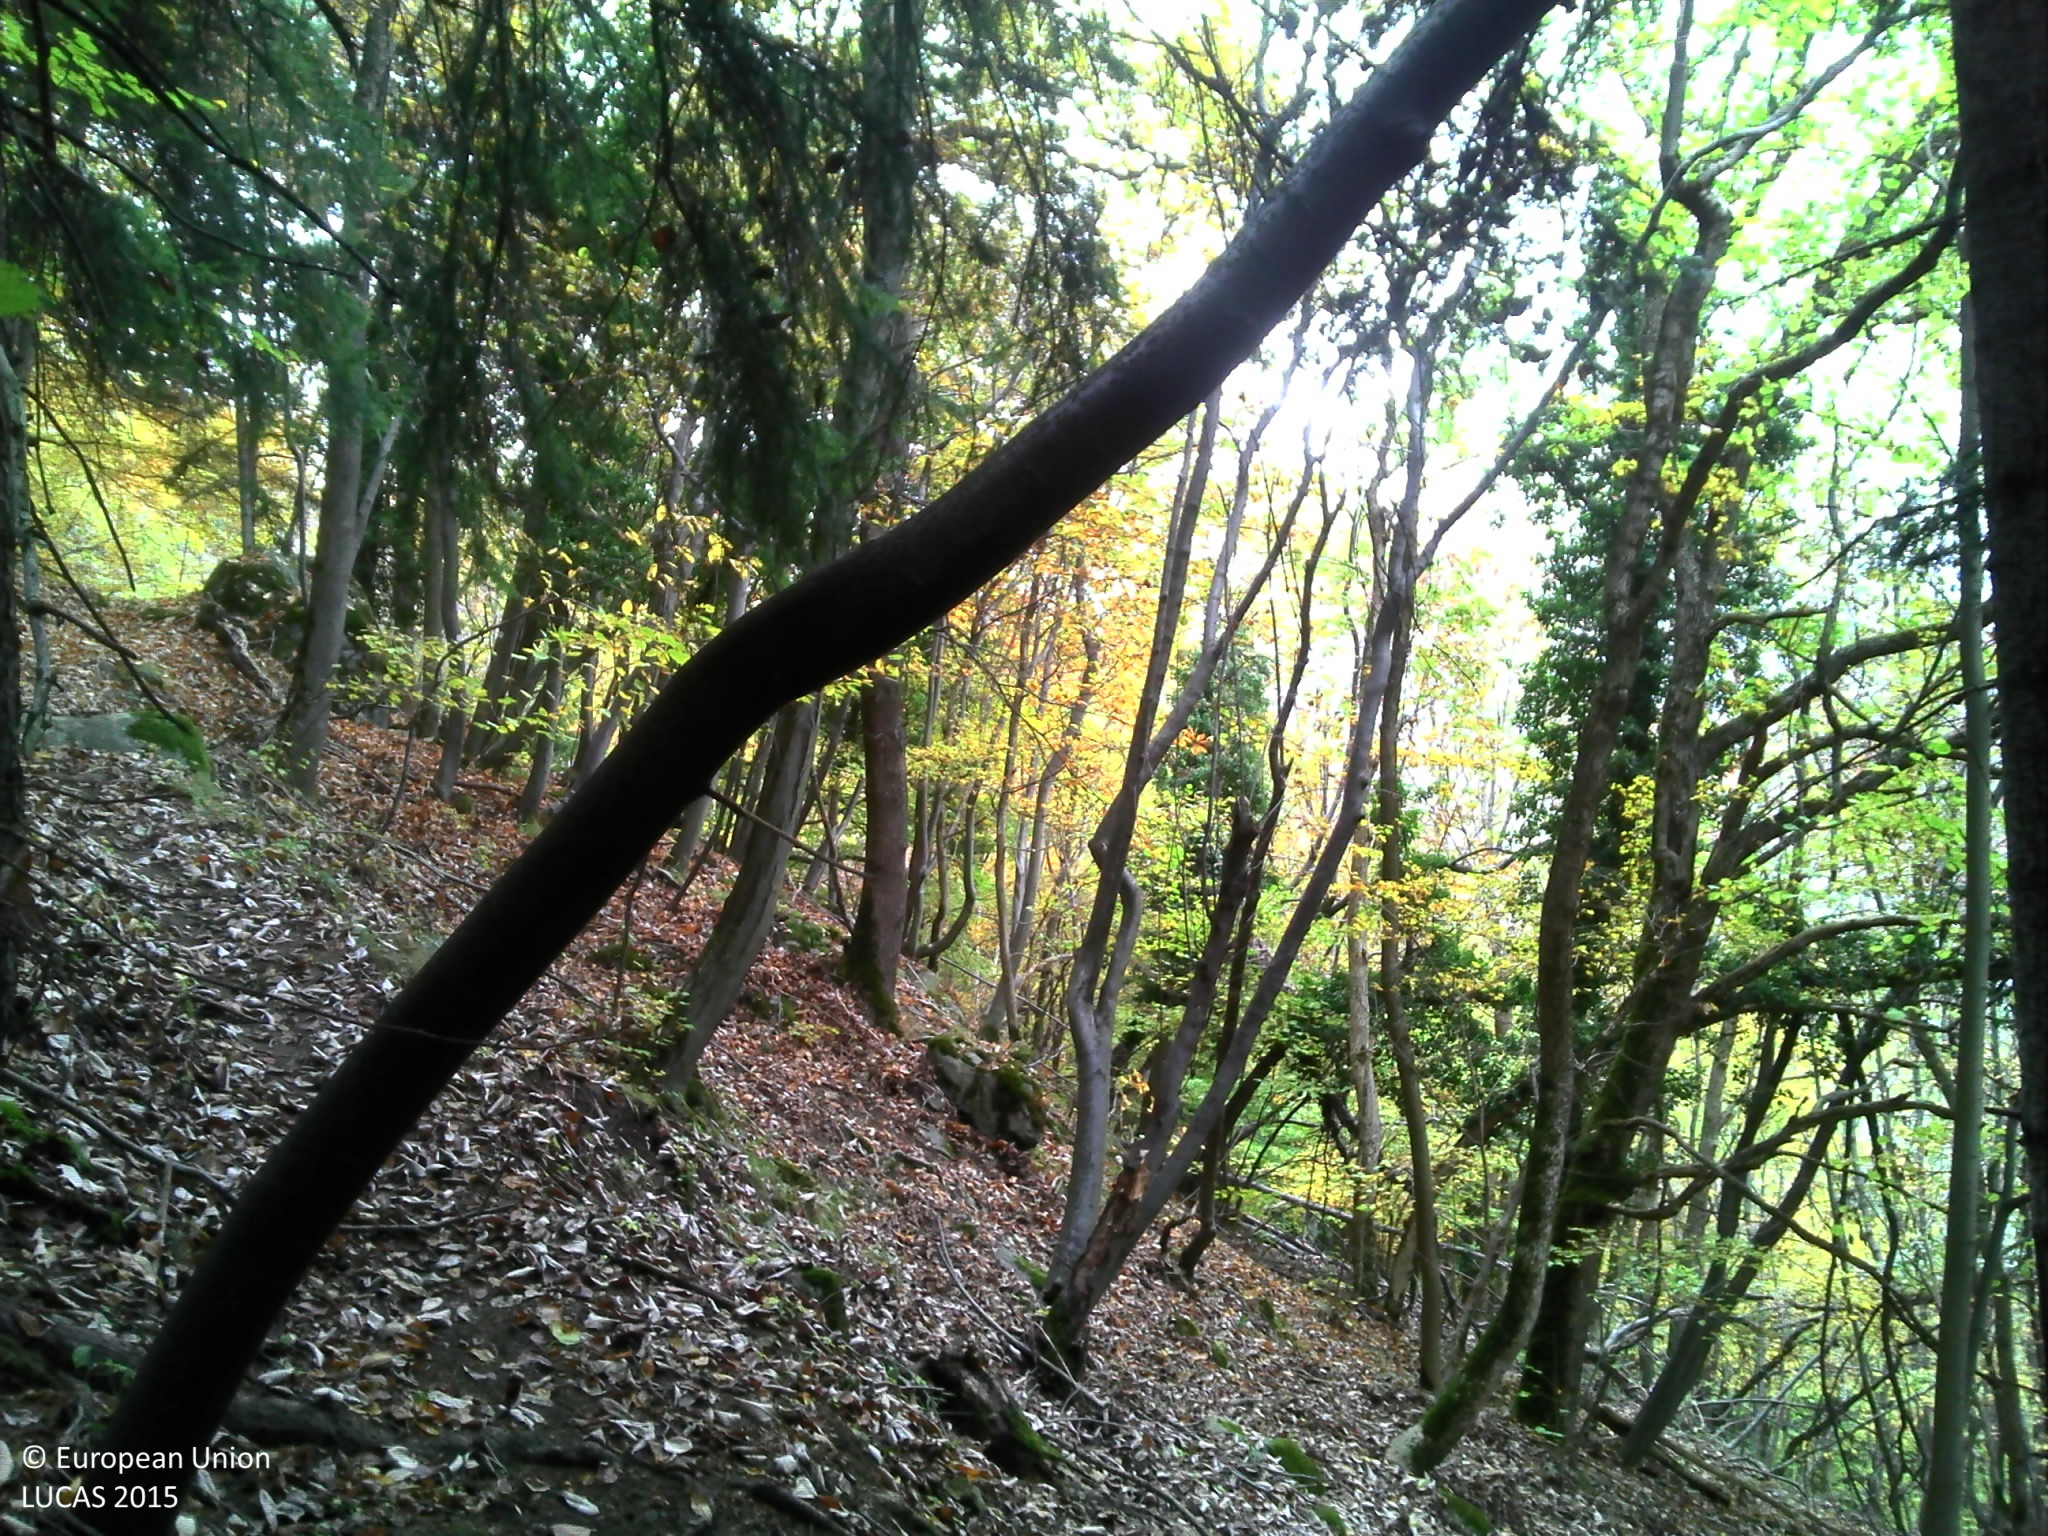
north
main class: Woodland
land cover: Spruce dominated mixed woodland
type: hemiboreal forest and nemoral coniferous forest and mixed broadleaved-coniferous forest
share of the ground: > 75 %
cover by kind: coniferous forest trees 50 %, broadleaved forest trees 40 %, unconsolidated bare surface 10 %
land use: Forestry
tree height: > 5 m
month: October
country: FR
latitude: 45.2103
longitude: 6.4527
